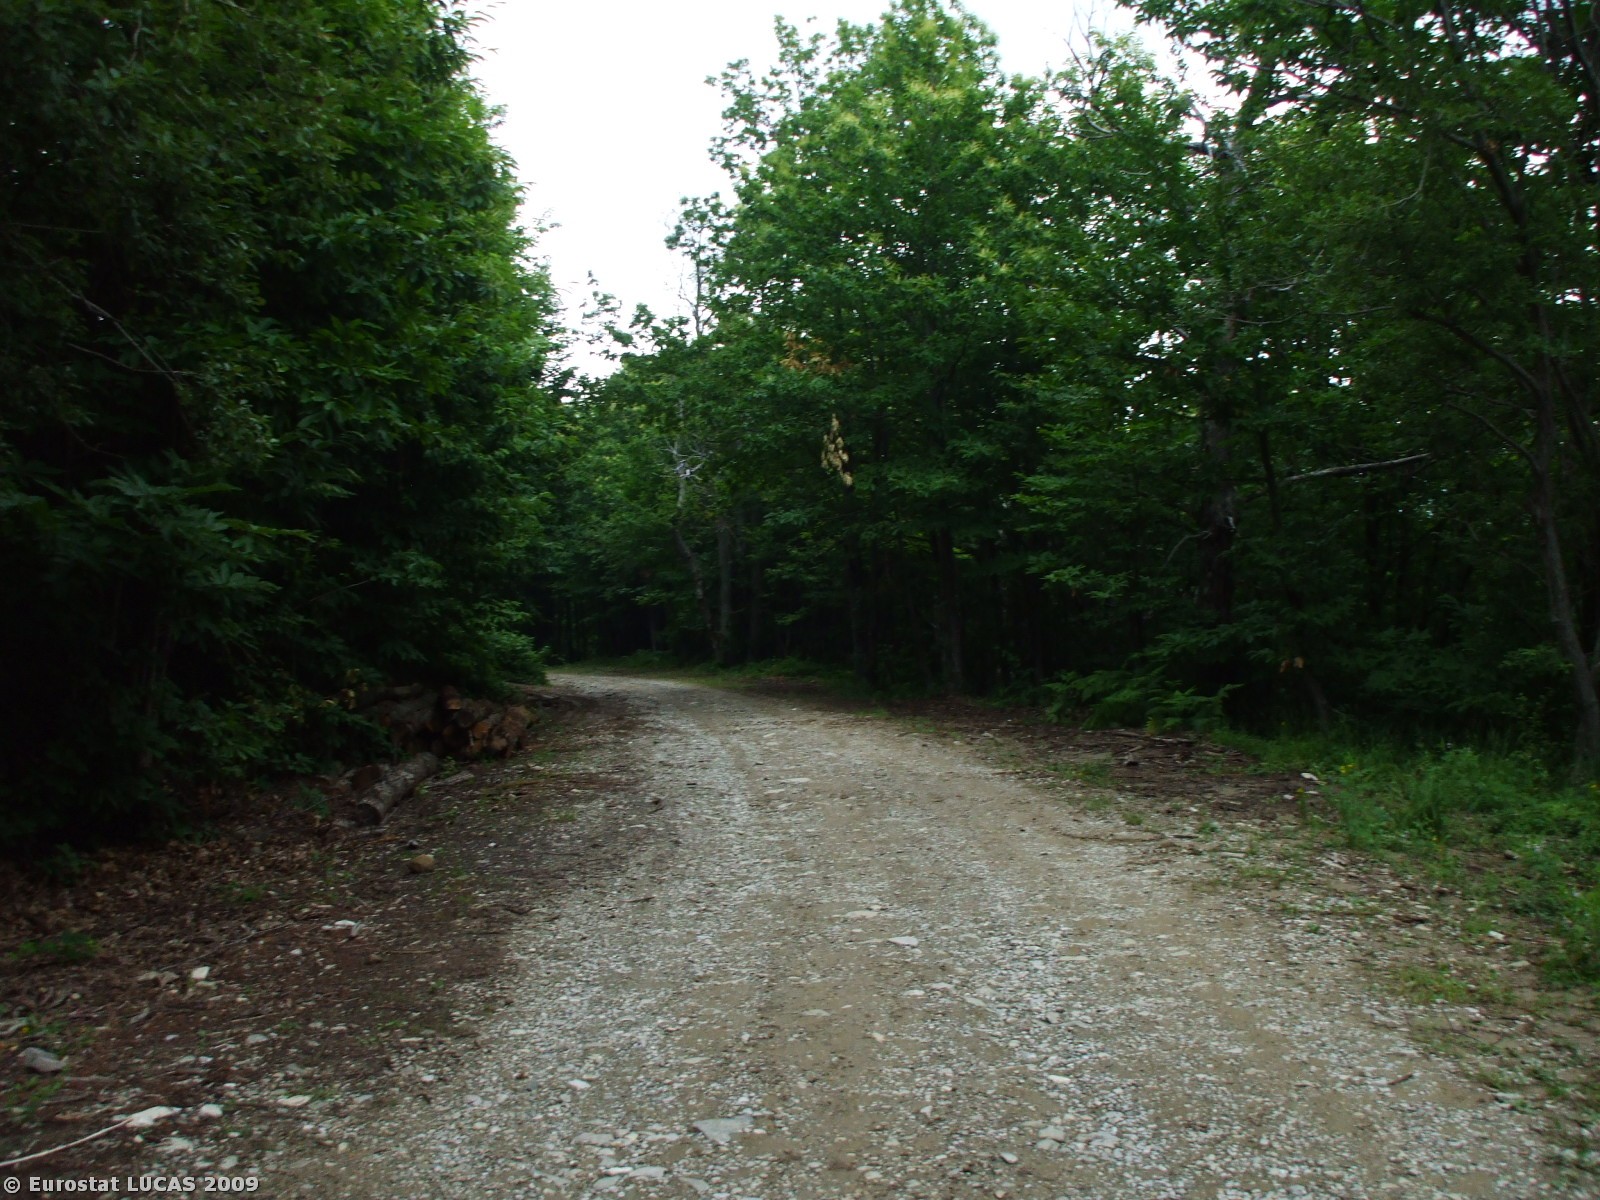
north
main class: Woodland
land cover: Broadleaved woodland
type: thermophilous deciduous forest
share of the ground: > 75 %
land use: Forestry
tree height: > 5 m
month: June
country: IT
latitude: 43.6691
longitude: 11.6946
